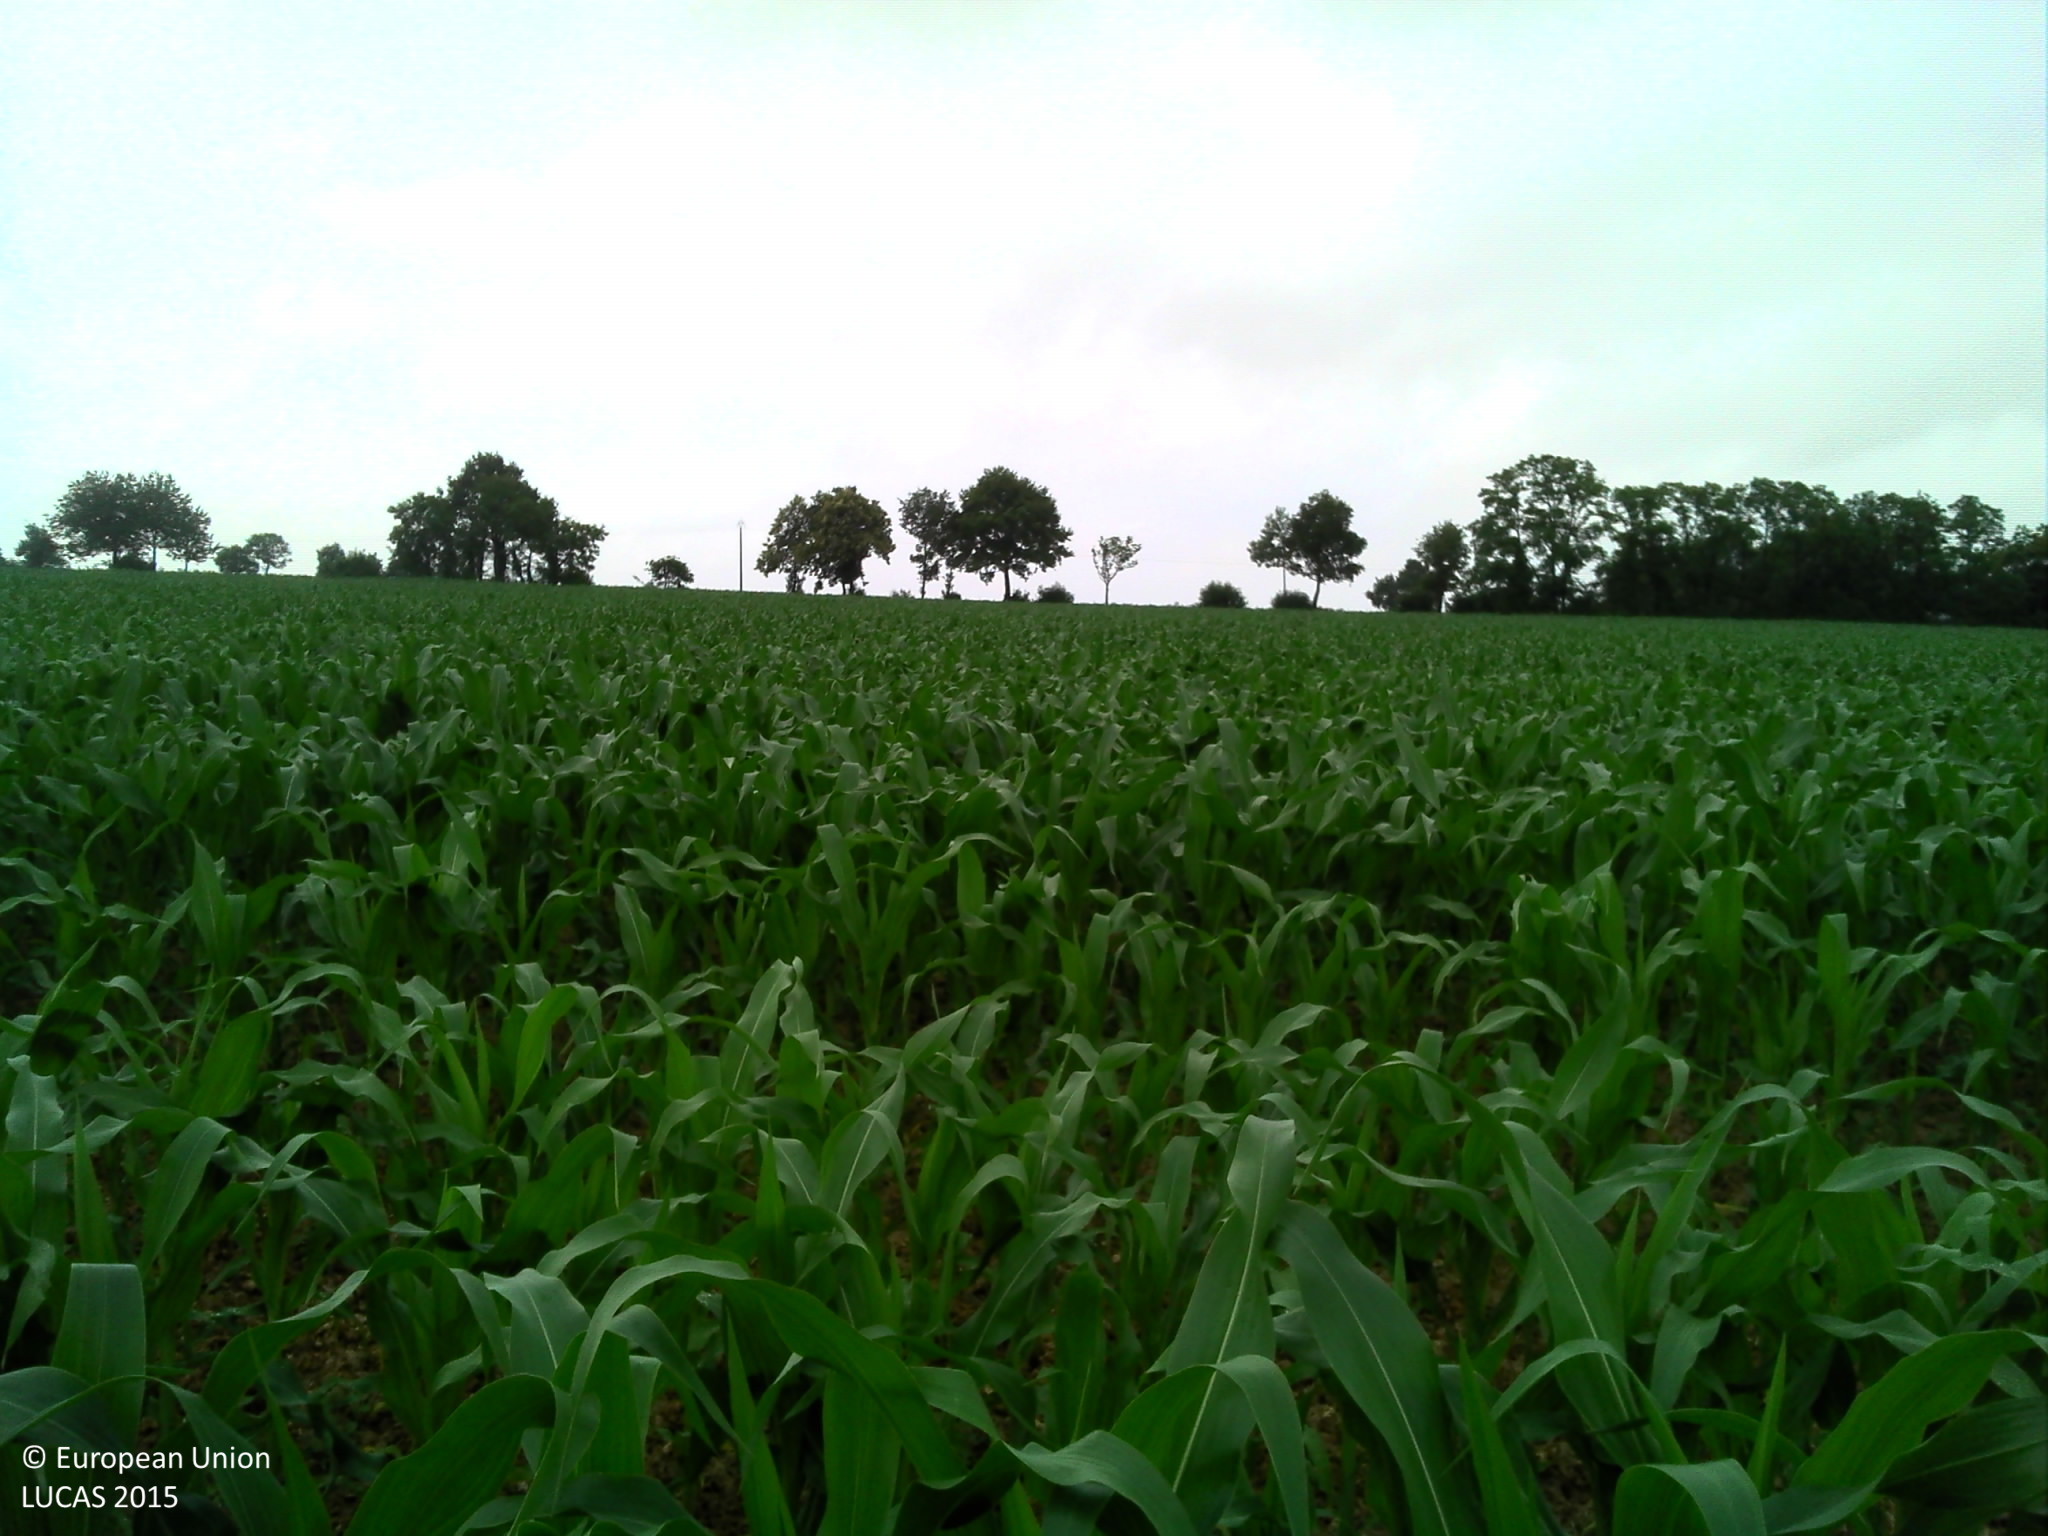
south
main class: Cropland
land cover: Maize
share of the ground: > 75 %
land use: Agriculture (excluding fallow land and kitchen gardens)
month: July
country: FR
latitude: 47.8875
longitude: -1.3704
